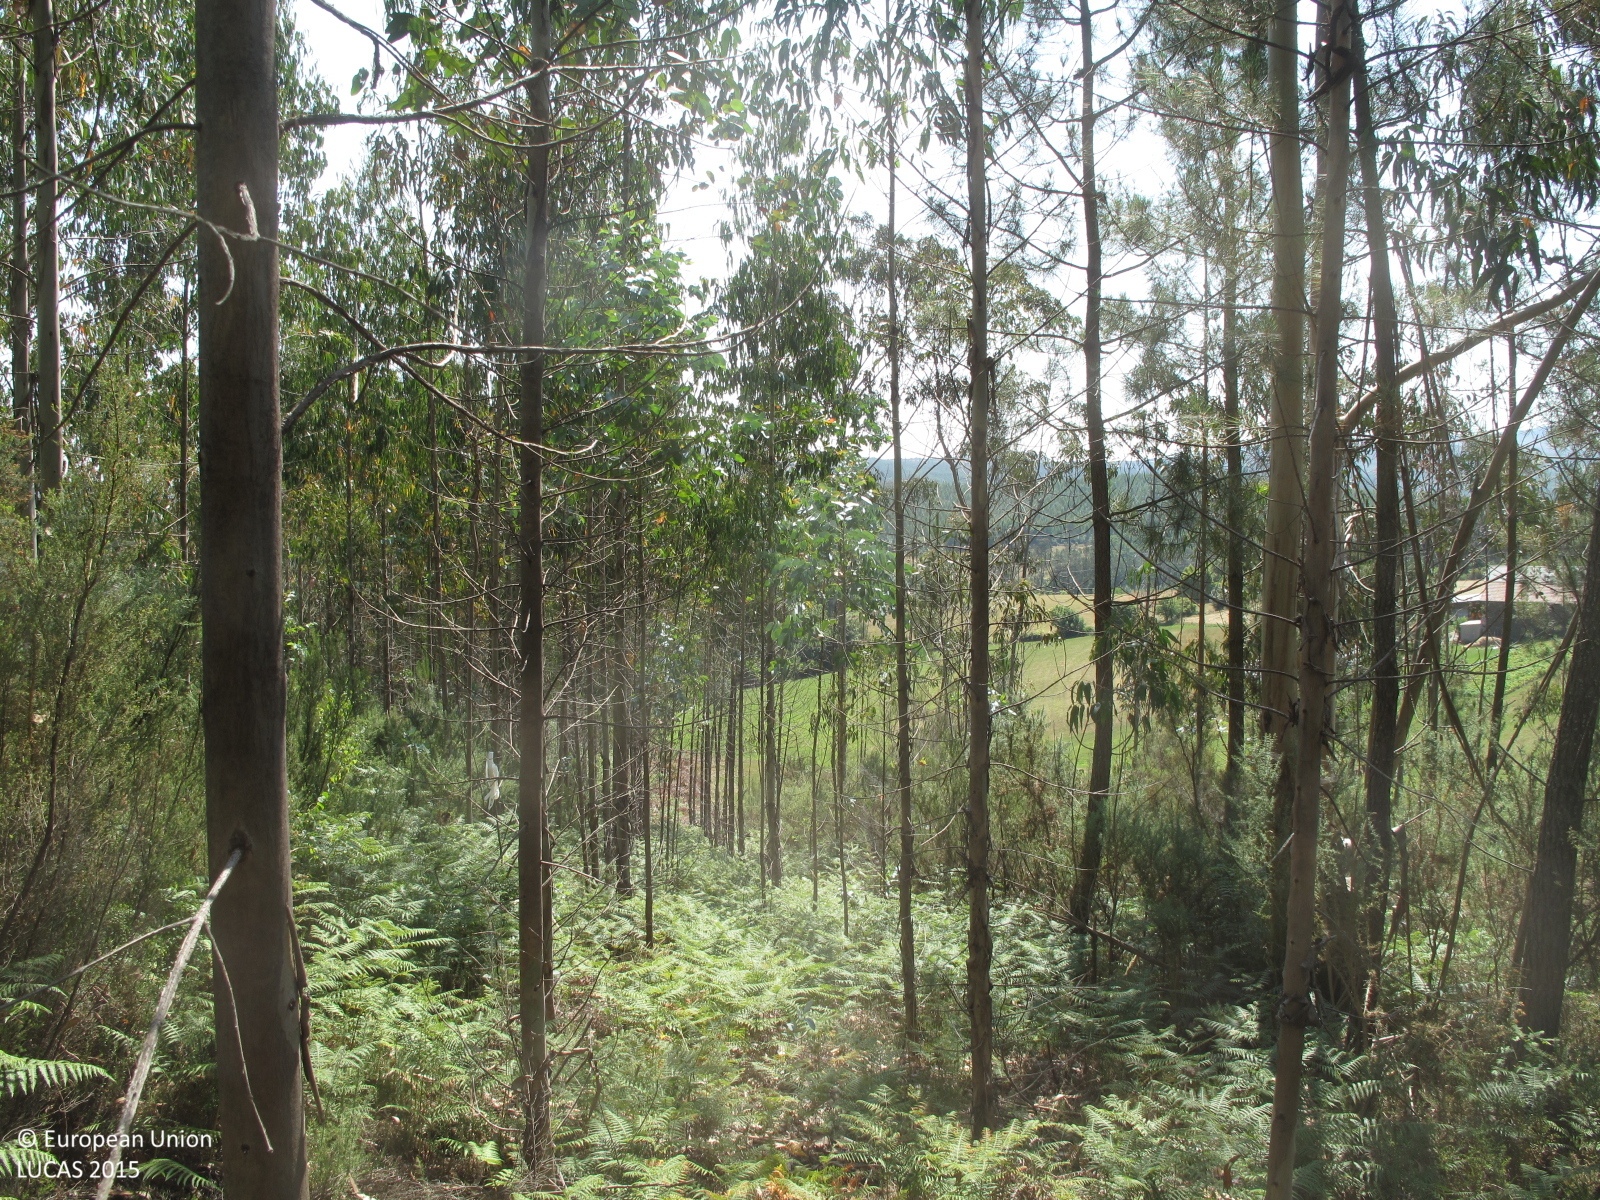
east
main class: Woodland
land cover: Broadleaved woodland
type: exotic forest
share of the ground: > 75 %
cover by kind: broadleaved forest trees 45 %, shrubs 30 %, herbaceous plants 20 %, coniferous forest trees 5 %
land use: Forestry
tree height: > 5 m
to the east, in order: Broadleaved woodland; Tracks; Broadleaved woodland; Pine dominated mixed woodland; Grassland without tree/shrub cover; Rivers and streams; Grassland without tree/shrub cover; Other mixed woodland
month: July
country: ES
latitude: 43.3953
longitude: -8.0603
